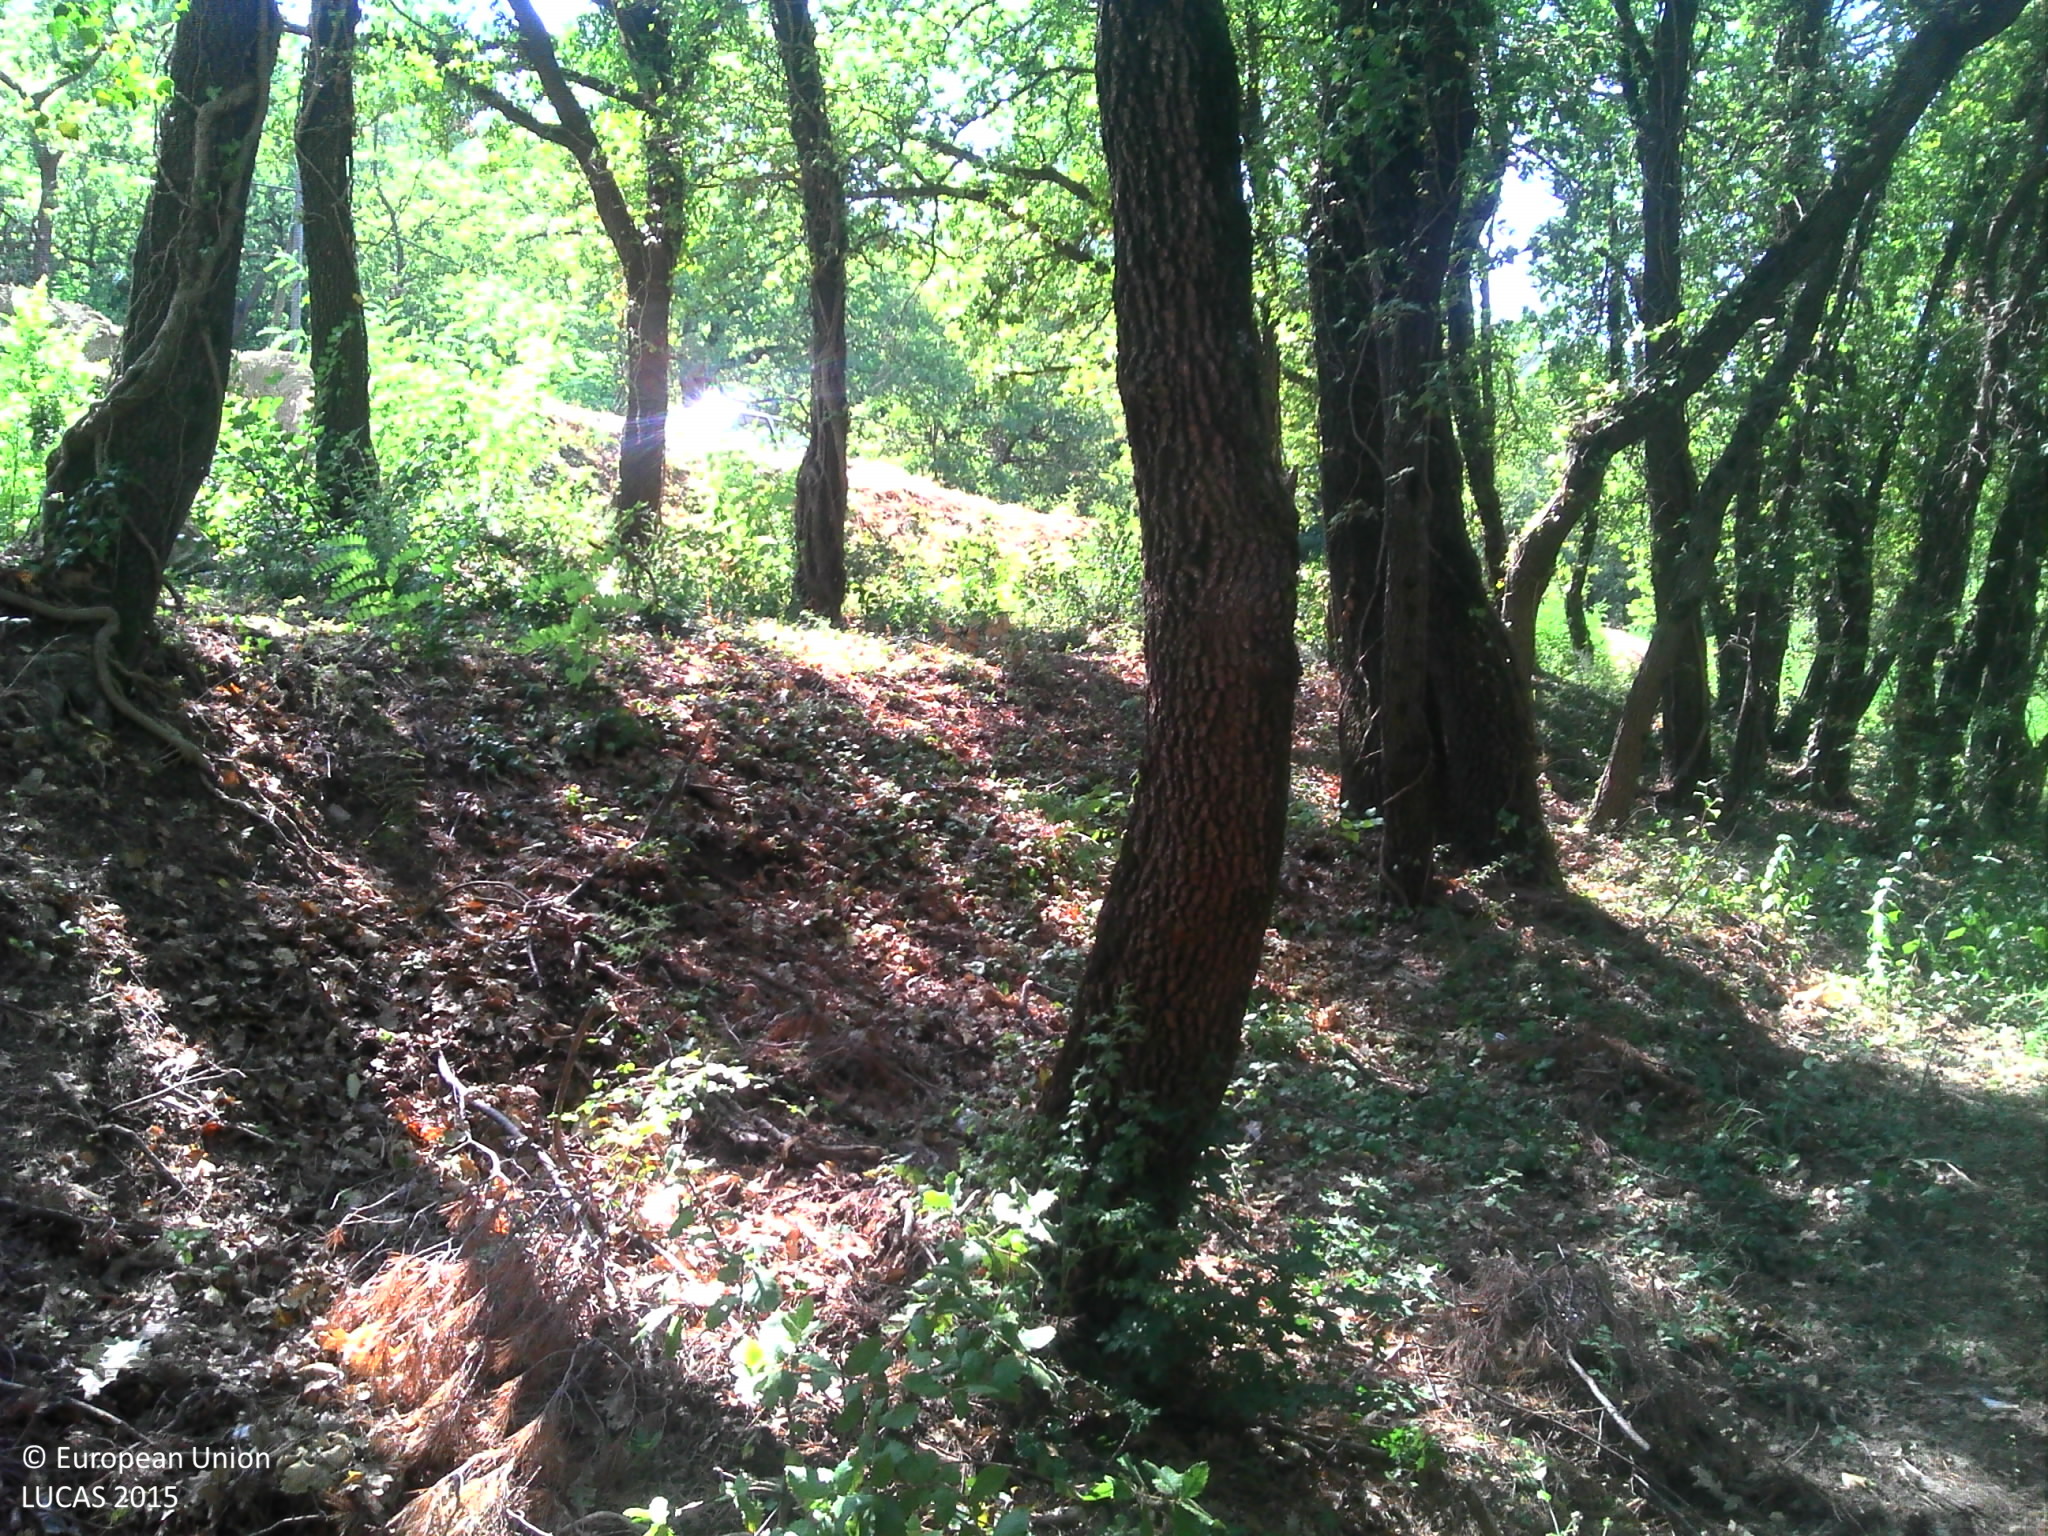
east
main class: Woodland
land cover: Pine dominated mixed woodland
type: coniferous forest of the mediterranean region
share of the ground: > 75 %
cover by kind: coniferous forest trees 50 %, broadleaved forest trees 50 %
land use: Forestry
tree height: > 5 m
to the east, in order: Pine dominated mixed woodland; Electric lines; Pine dominated mixed woodland; Artificial constructions in urban areas; Broadleaved woodland
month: August
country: FR
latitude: 43.3880
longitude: 5.5535
